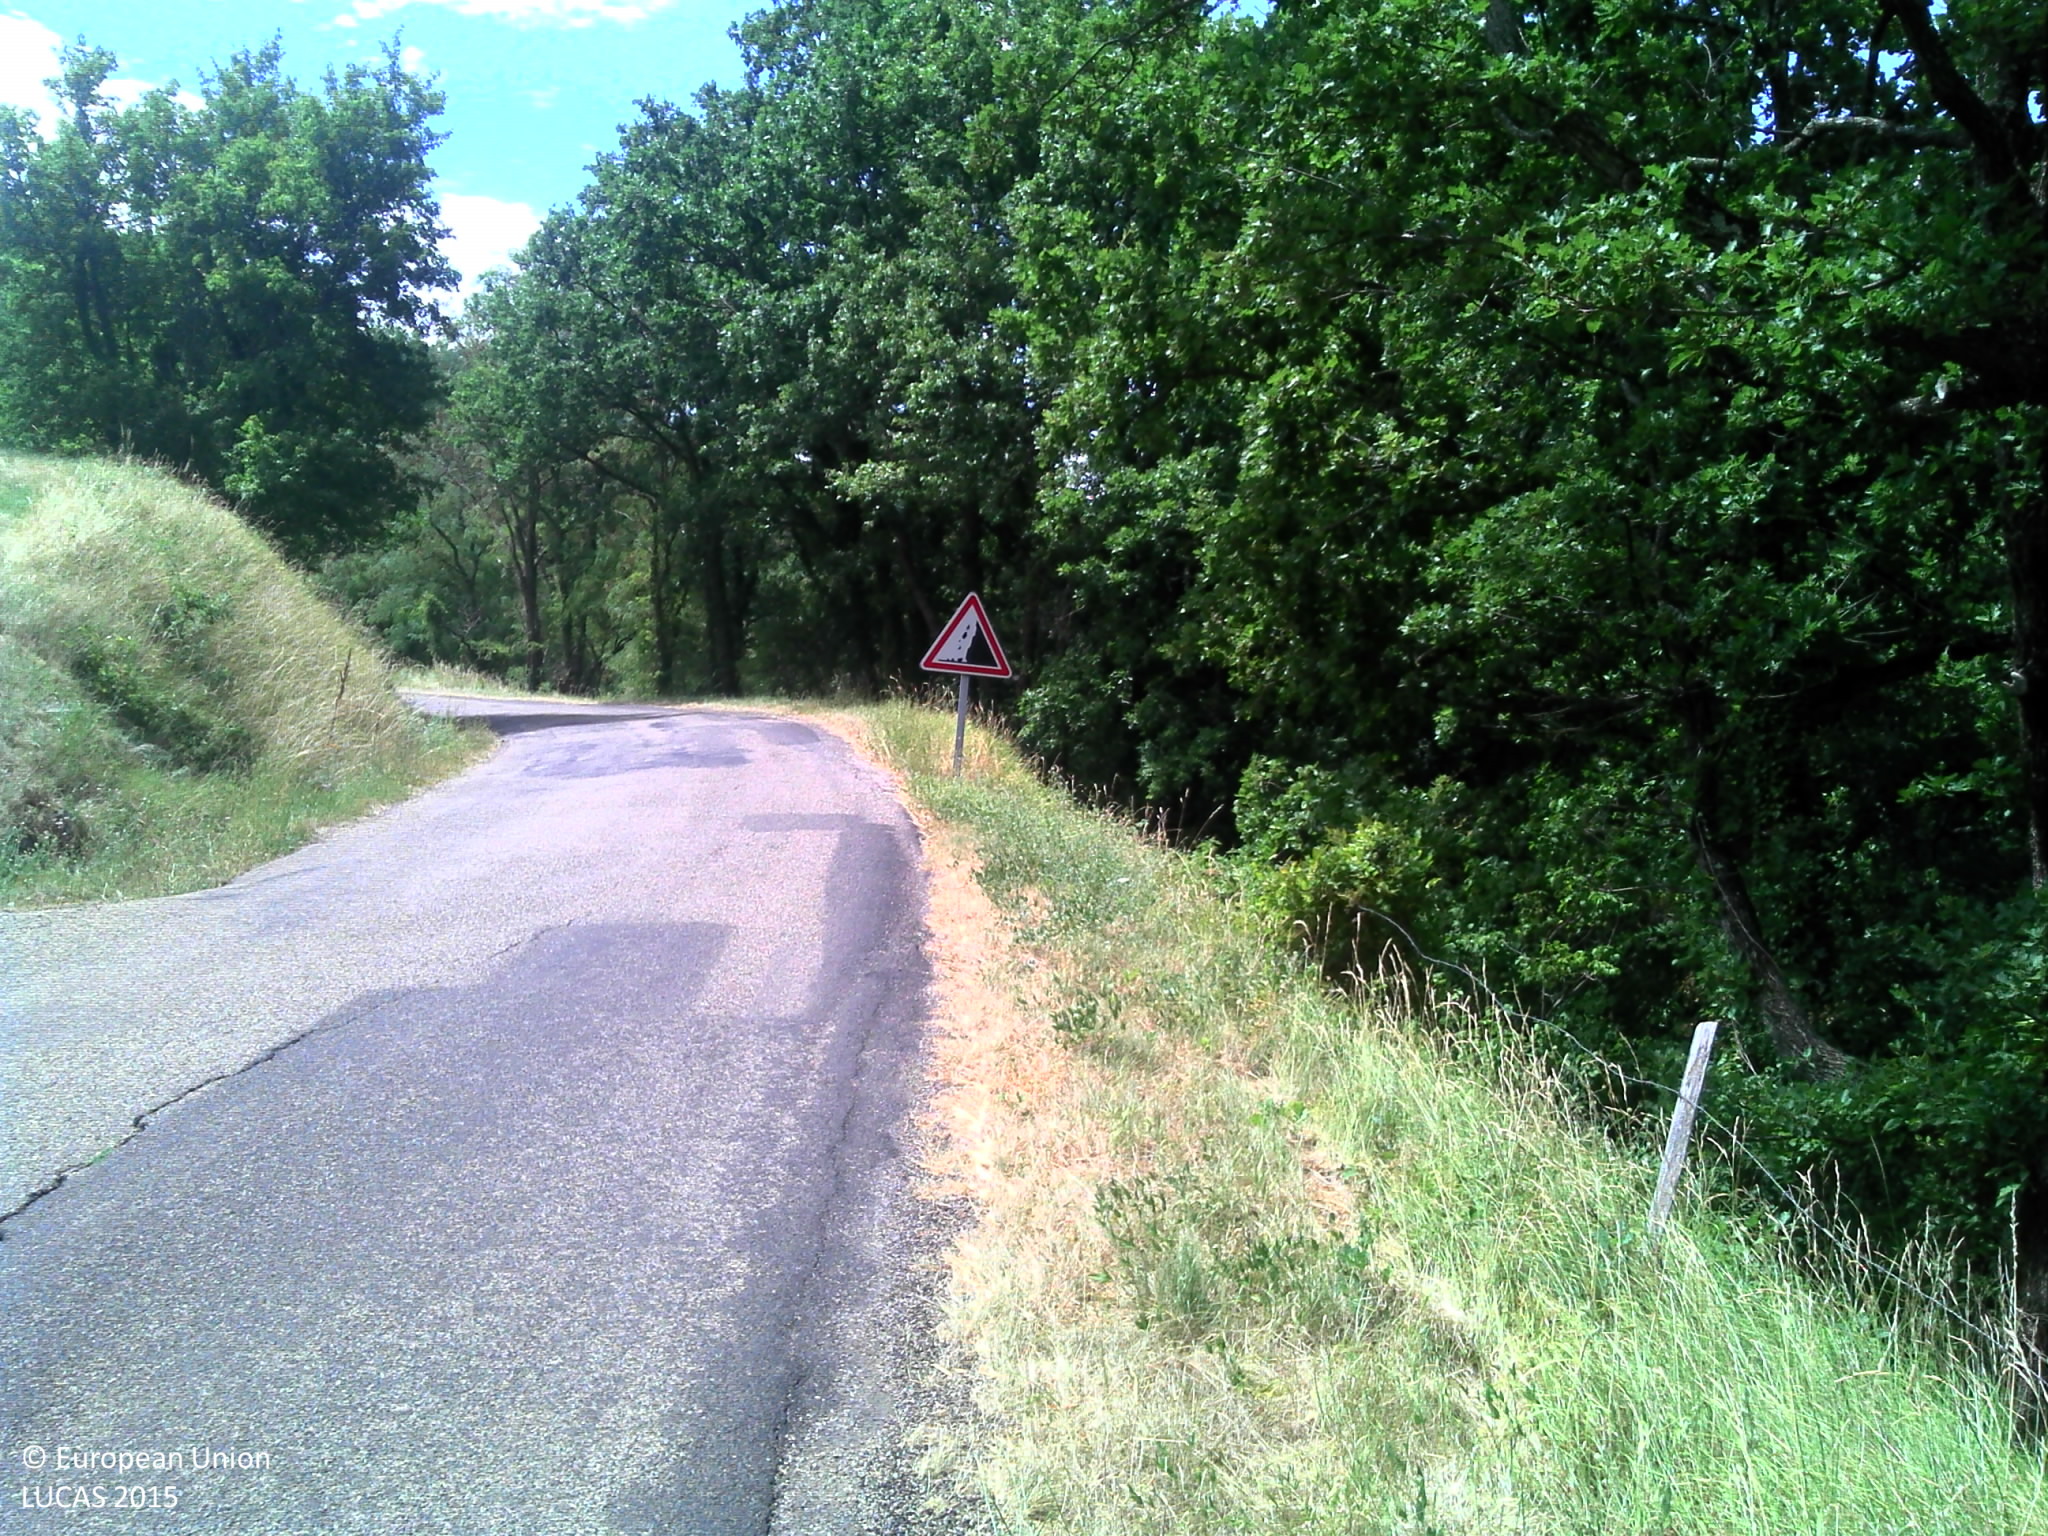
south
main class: Woodland
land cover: Broadleaved woodland
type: broadleaved evergreen forest
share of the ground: > 75 %
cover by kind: broadleaved forest trees 80 %, shrubs 10 %, herbaceous plants 10 %
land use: Semi-natural and natural areas not in use
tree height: > 5 m
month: July
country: FR
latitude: 44.6076
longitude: 4.6010
